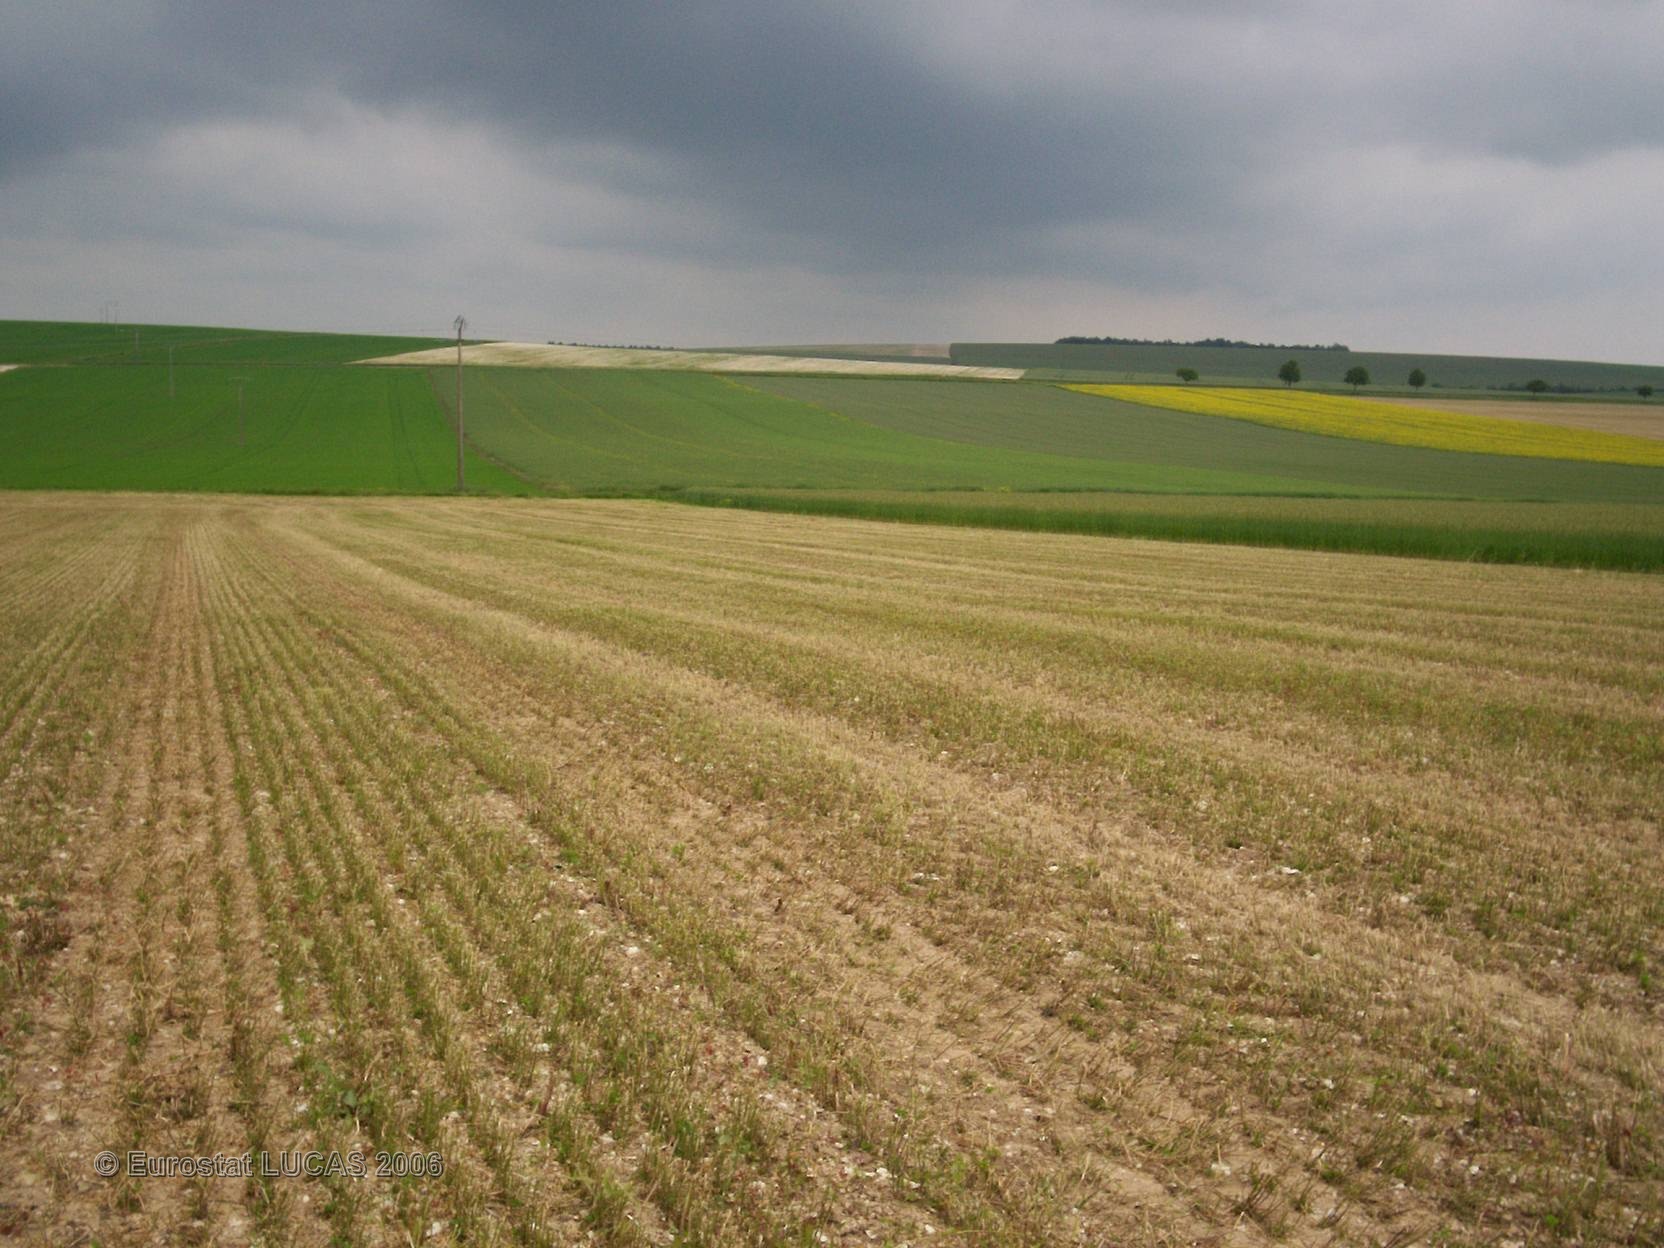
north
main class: Cropland
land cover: Lucerne
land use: Agriculture (excluding fallow land and kitchen gardens)
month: June
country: FR
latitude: 48.6812
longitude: 4.4962
